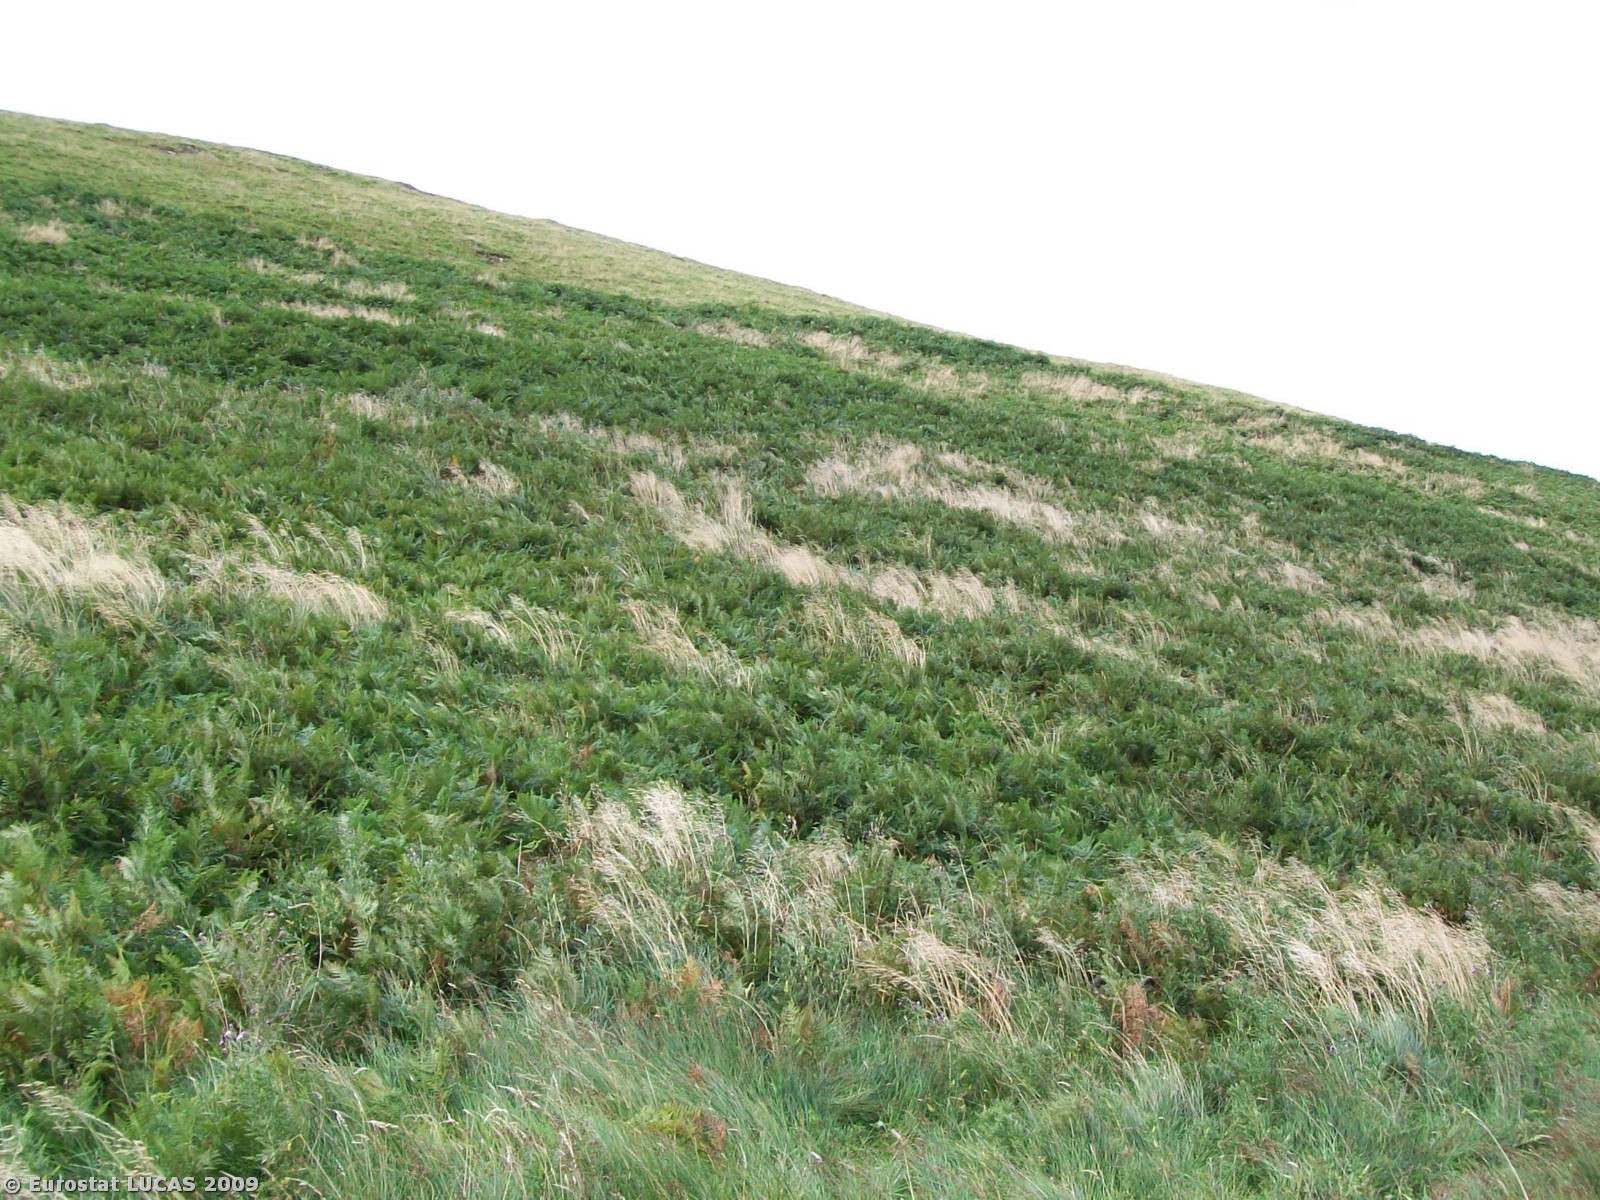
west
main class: Grassland
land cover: Grassland without tree/shrub cover
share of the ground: > 75 %
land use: Agriculture (excluding fallow land and kitchen gardens)
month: August
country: GB
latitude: 55.5441
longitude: -2.2441
